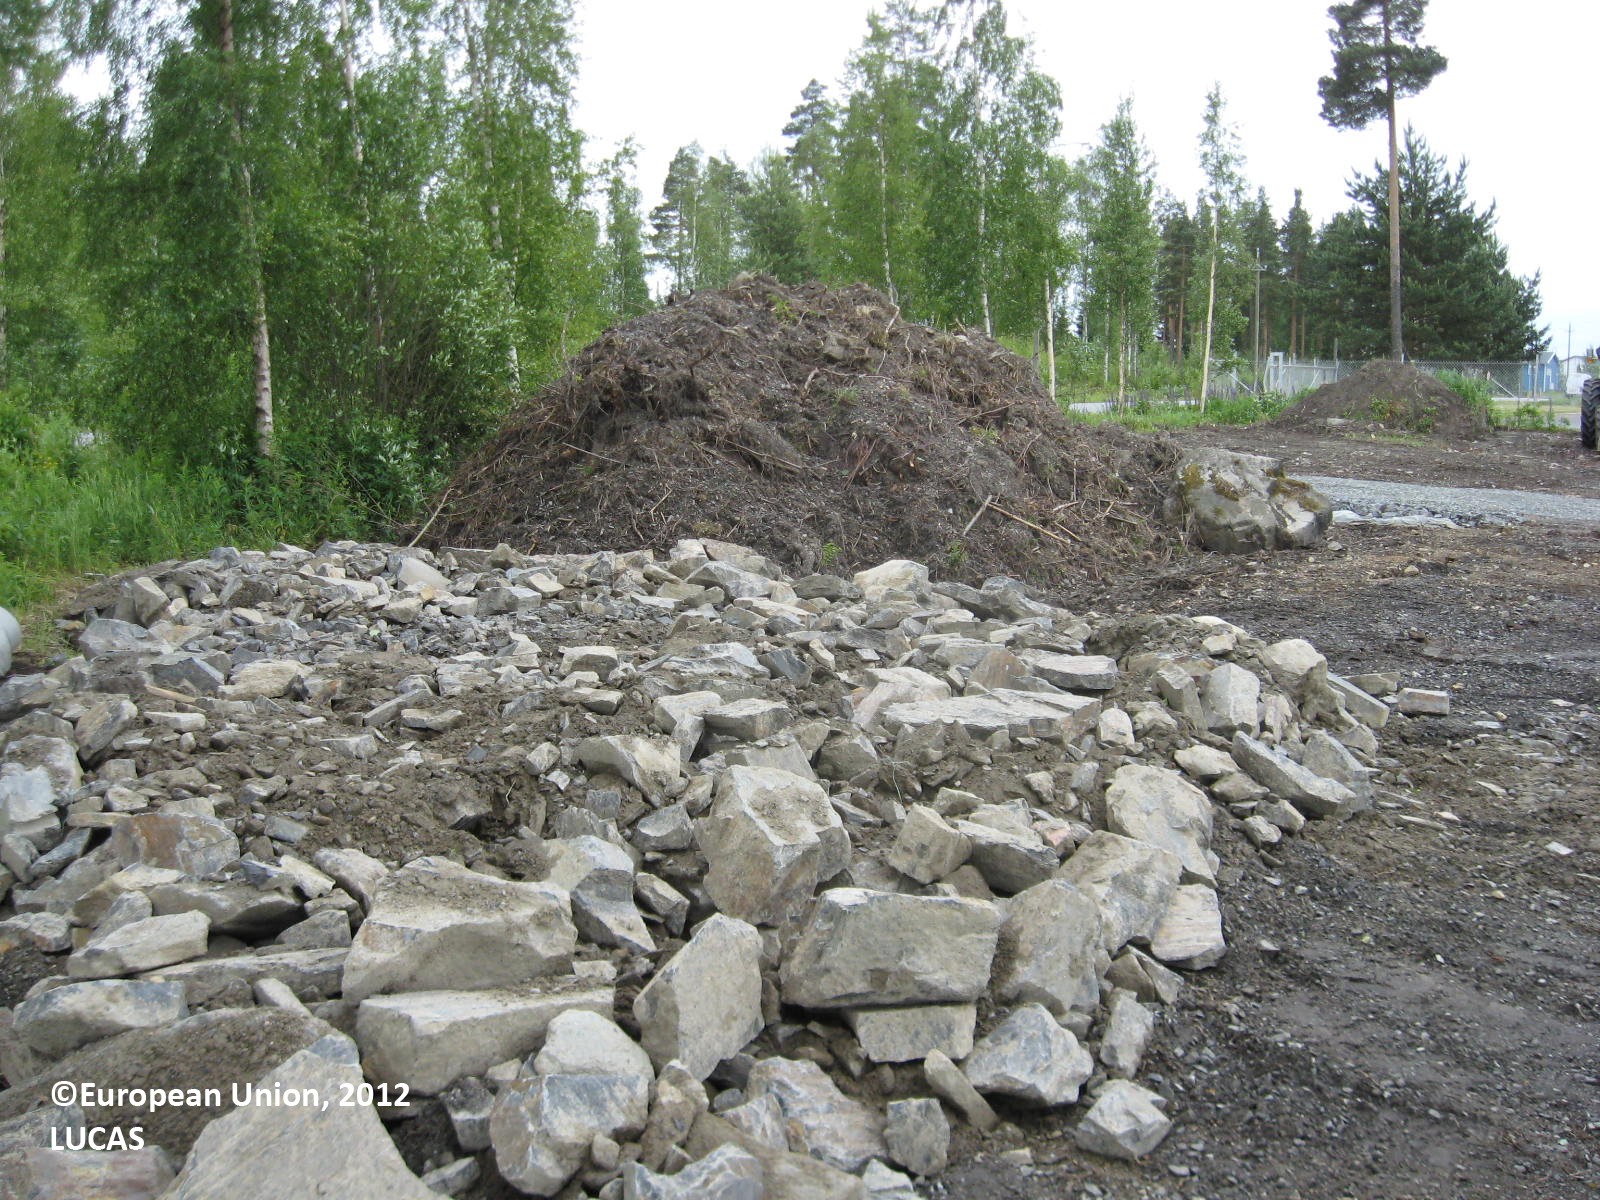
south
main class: Woodland
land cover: Broadleaved woodland
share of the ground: > 75 %
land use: Commerce, finance, business
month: June
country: FI
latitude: 62.7875
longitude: 22.8980
